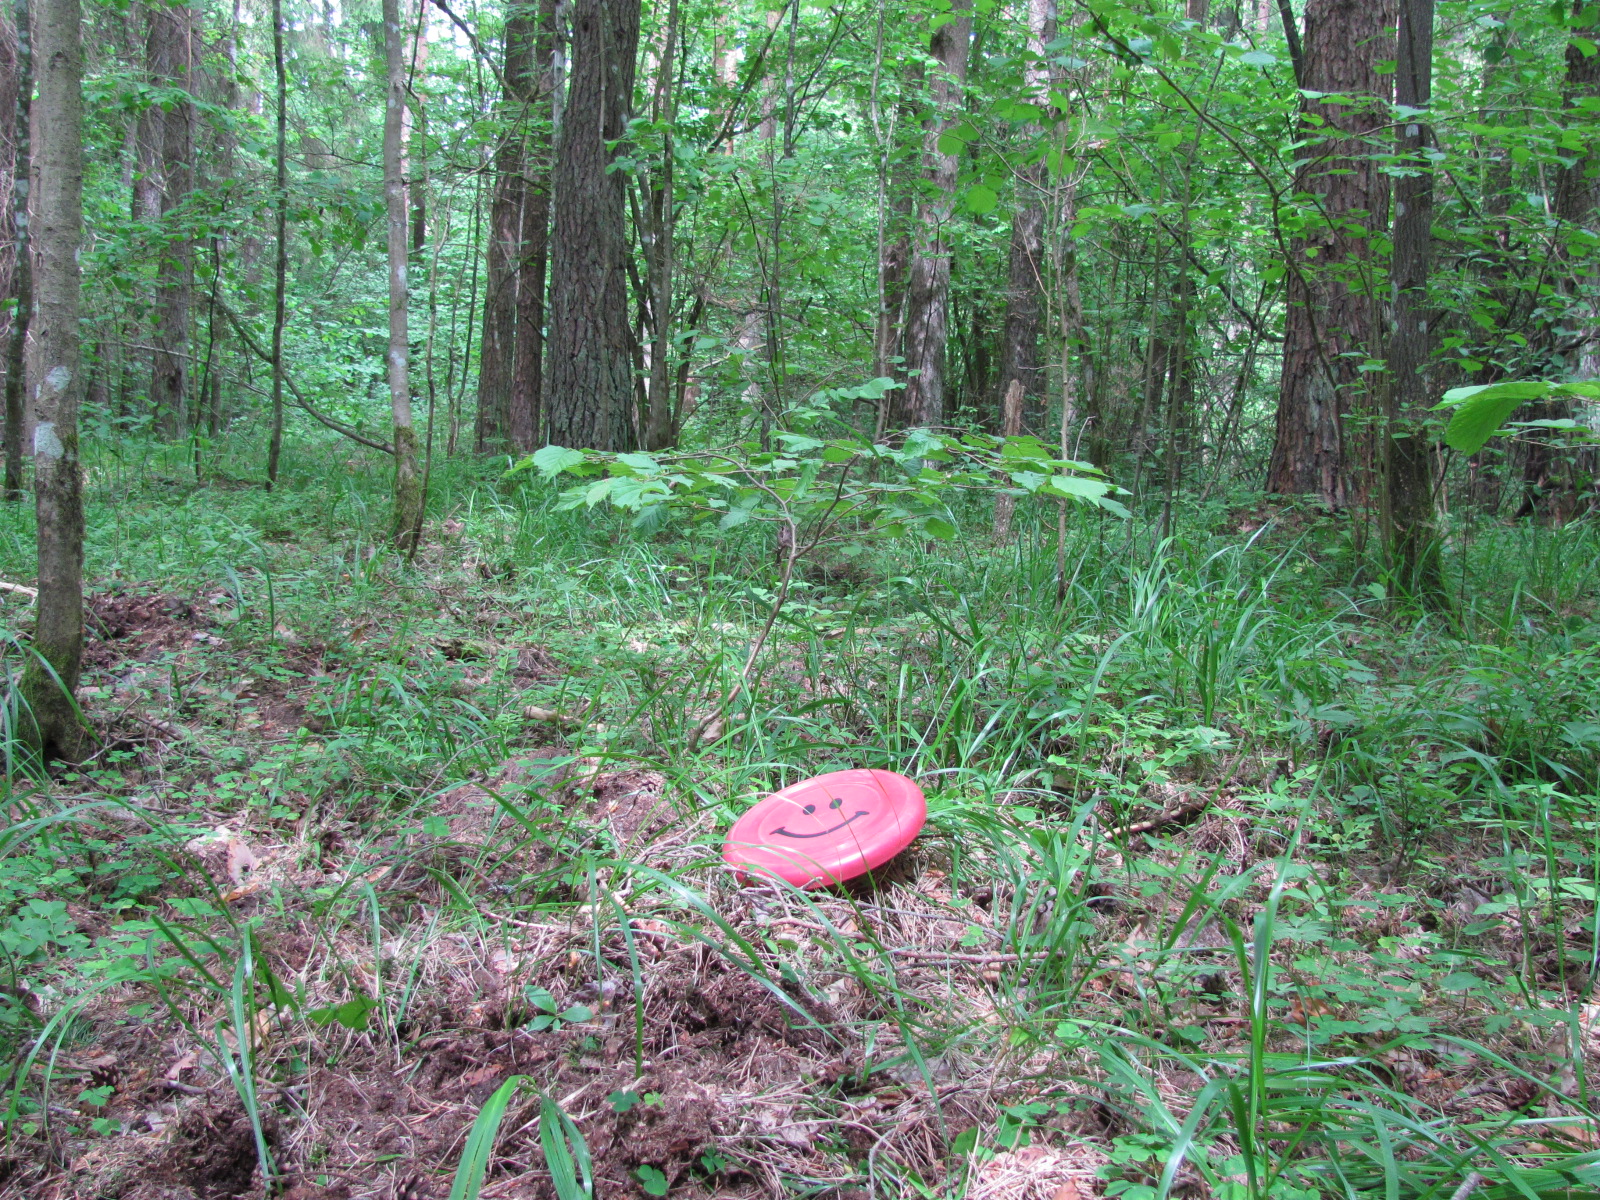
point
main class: Woodland
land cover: Other mixed woodland
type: hemiboreal forest and nemoral coniferous forest and mixed broadleaved-coniferous forest
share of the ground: > 75 %
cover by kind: coniferous forest trees 50 %, broadleaved forest trees 50 %
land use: Forestry
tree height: > 5 m
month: June
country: LV
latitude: 56.6054
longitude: 23.8138
